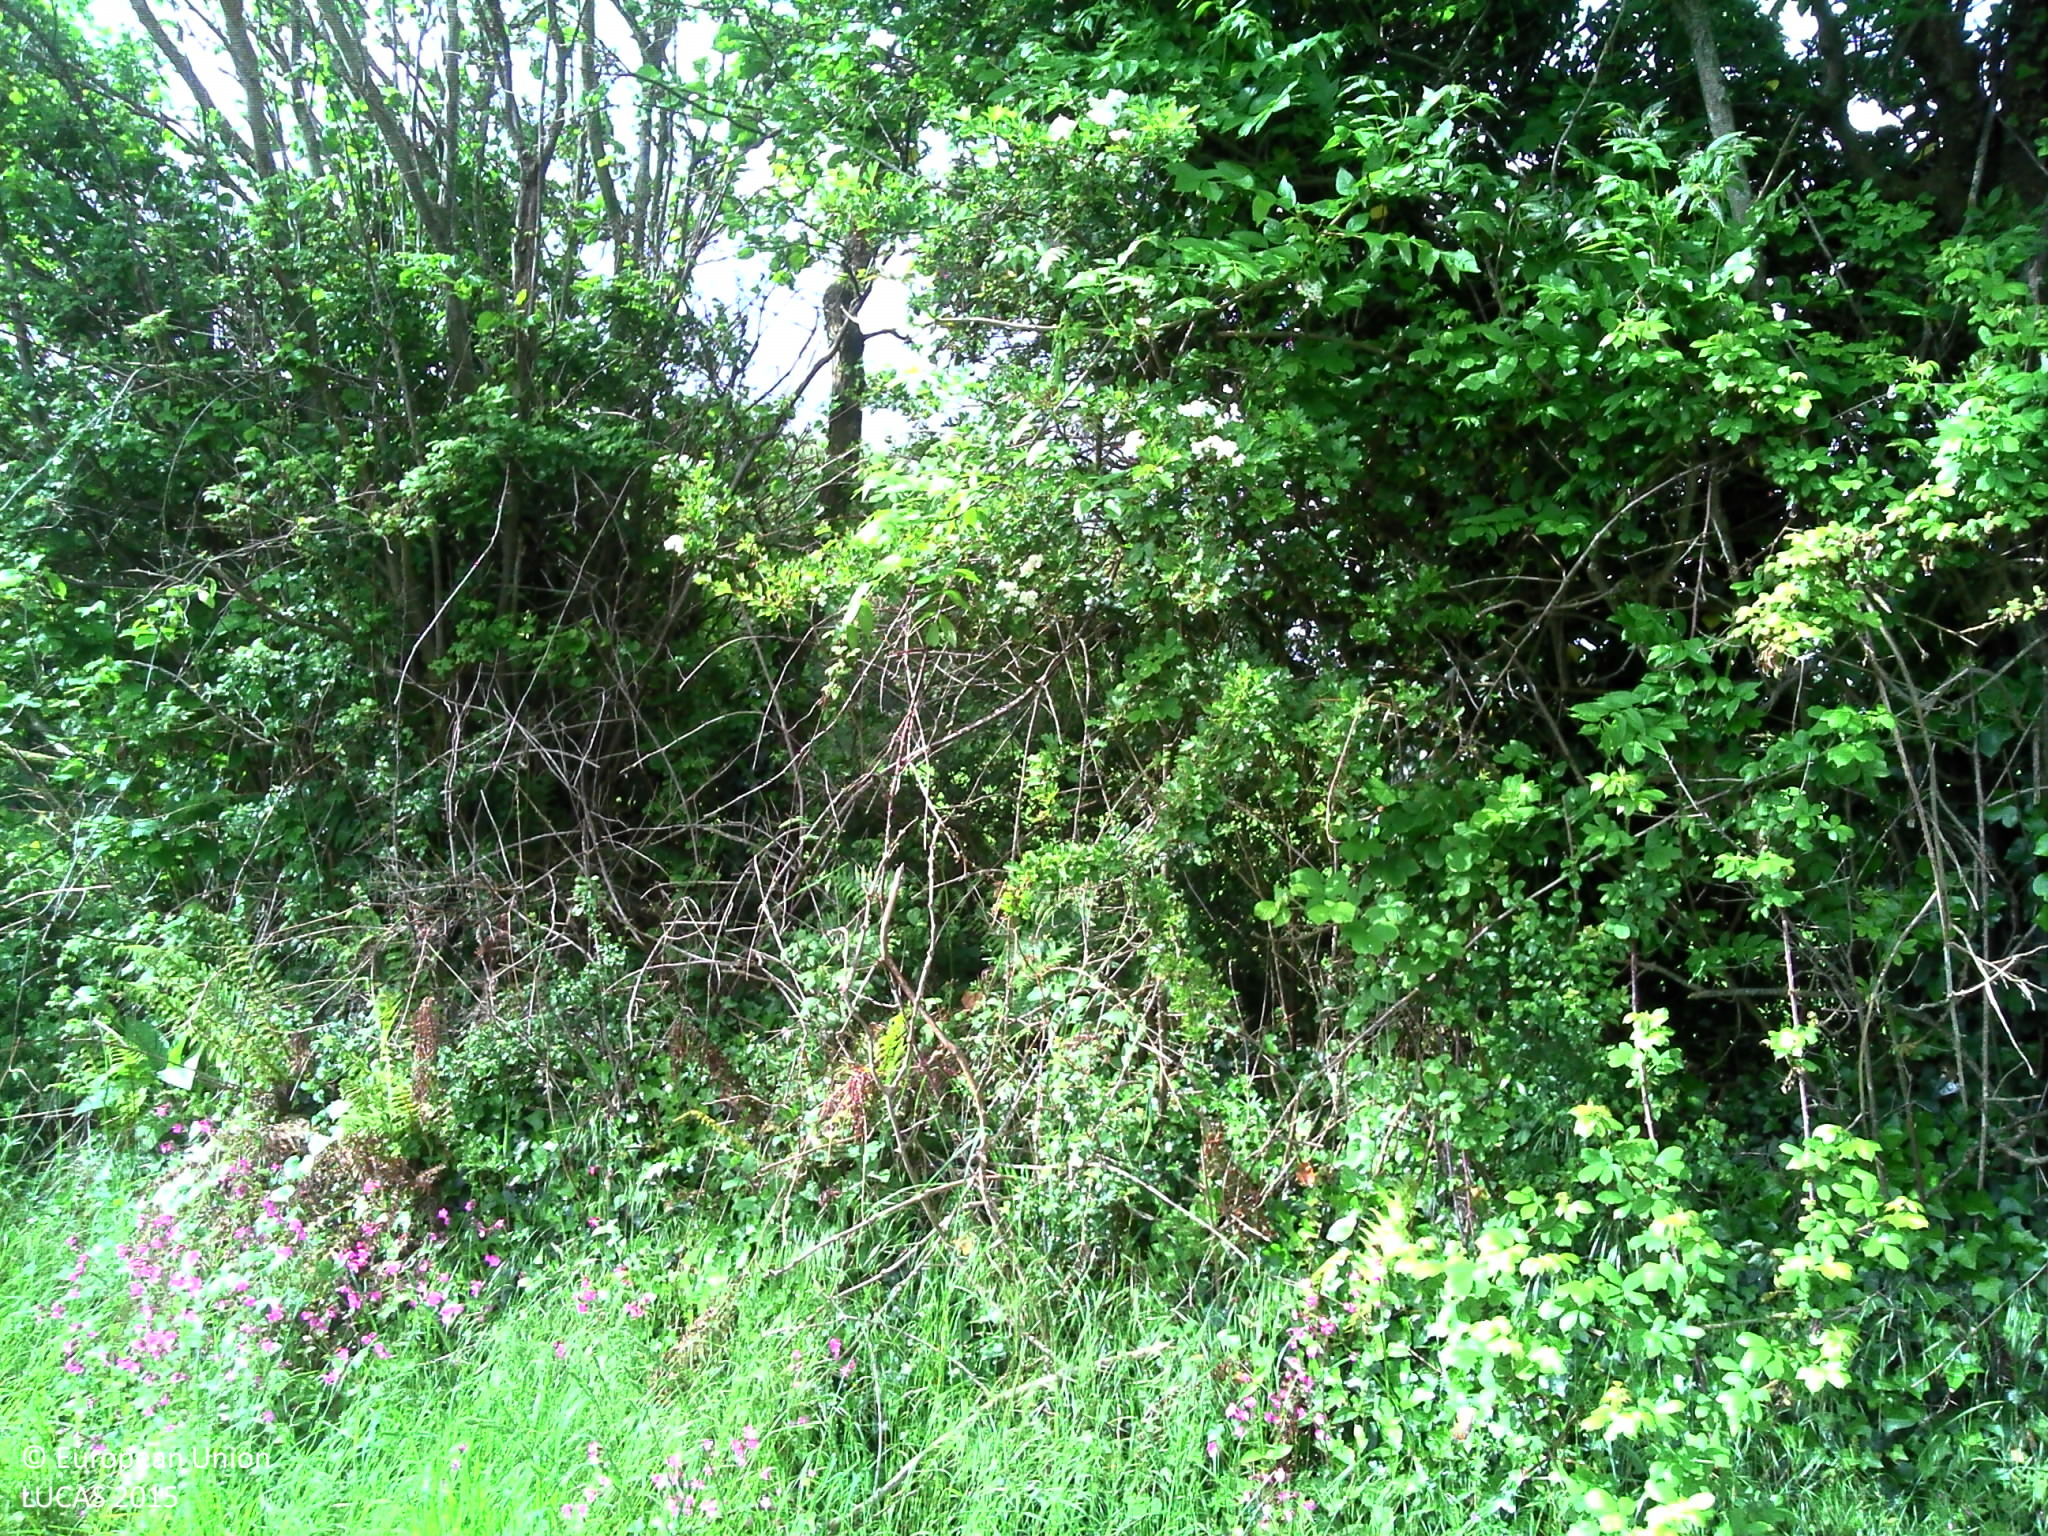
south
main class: Cropland
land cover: Maize
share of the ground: 10 - 25 %
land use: Agriculture (excluding fallow land and kitchen gardens)
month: June
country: FR
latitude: 49.6491
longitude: -1.7286
